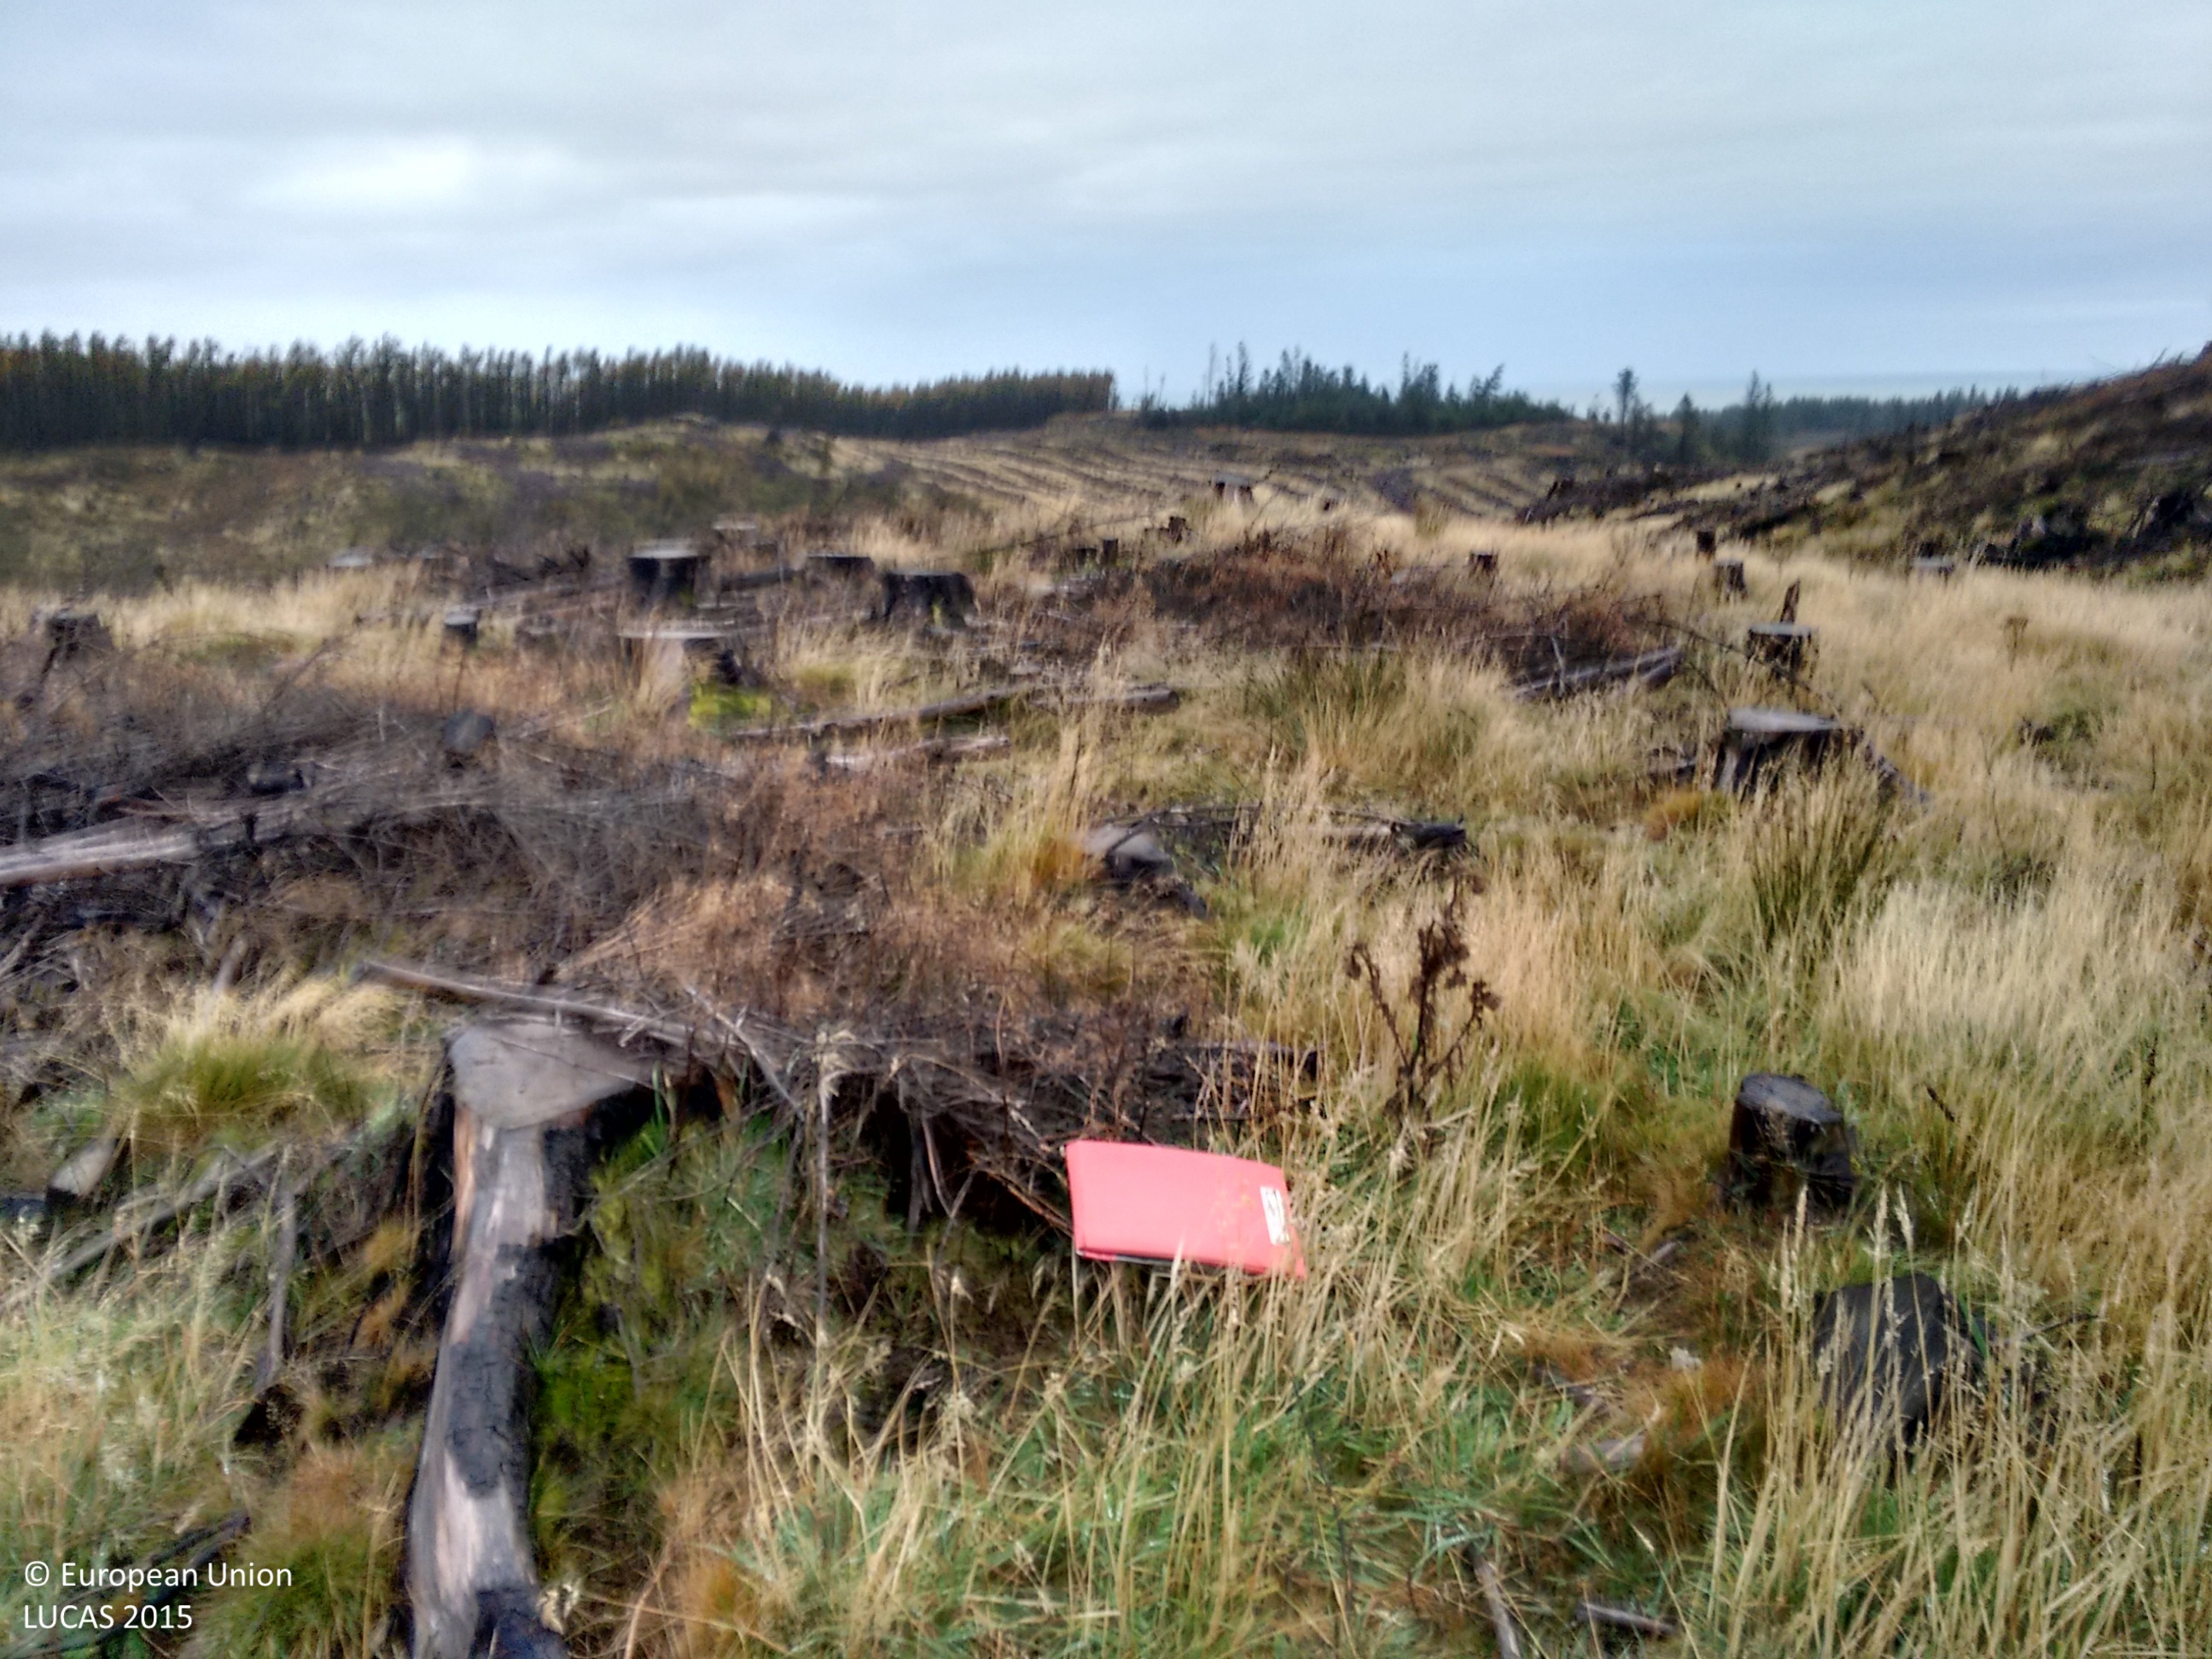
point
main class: Grassland
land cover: Grassland without tree/shrub cover
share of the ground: > 75 %
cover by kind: herbaceous plants 75 %, lichens and mosses 5 %
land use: Forestry
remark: Clear cut
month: October
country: GB
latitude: 56.5948
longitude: -6.2469
